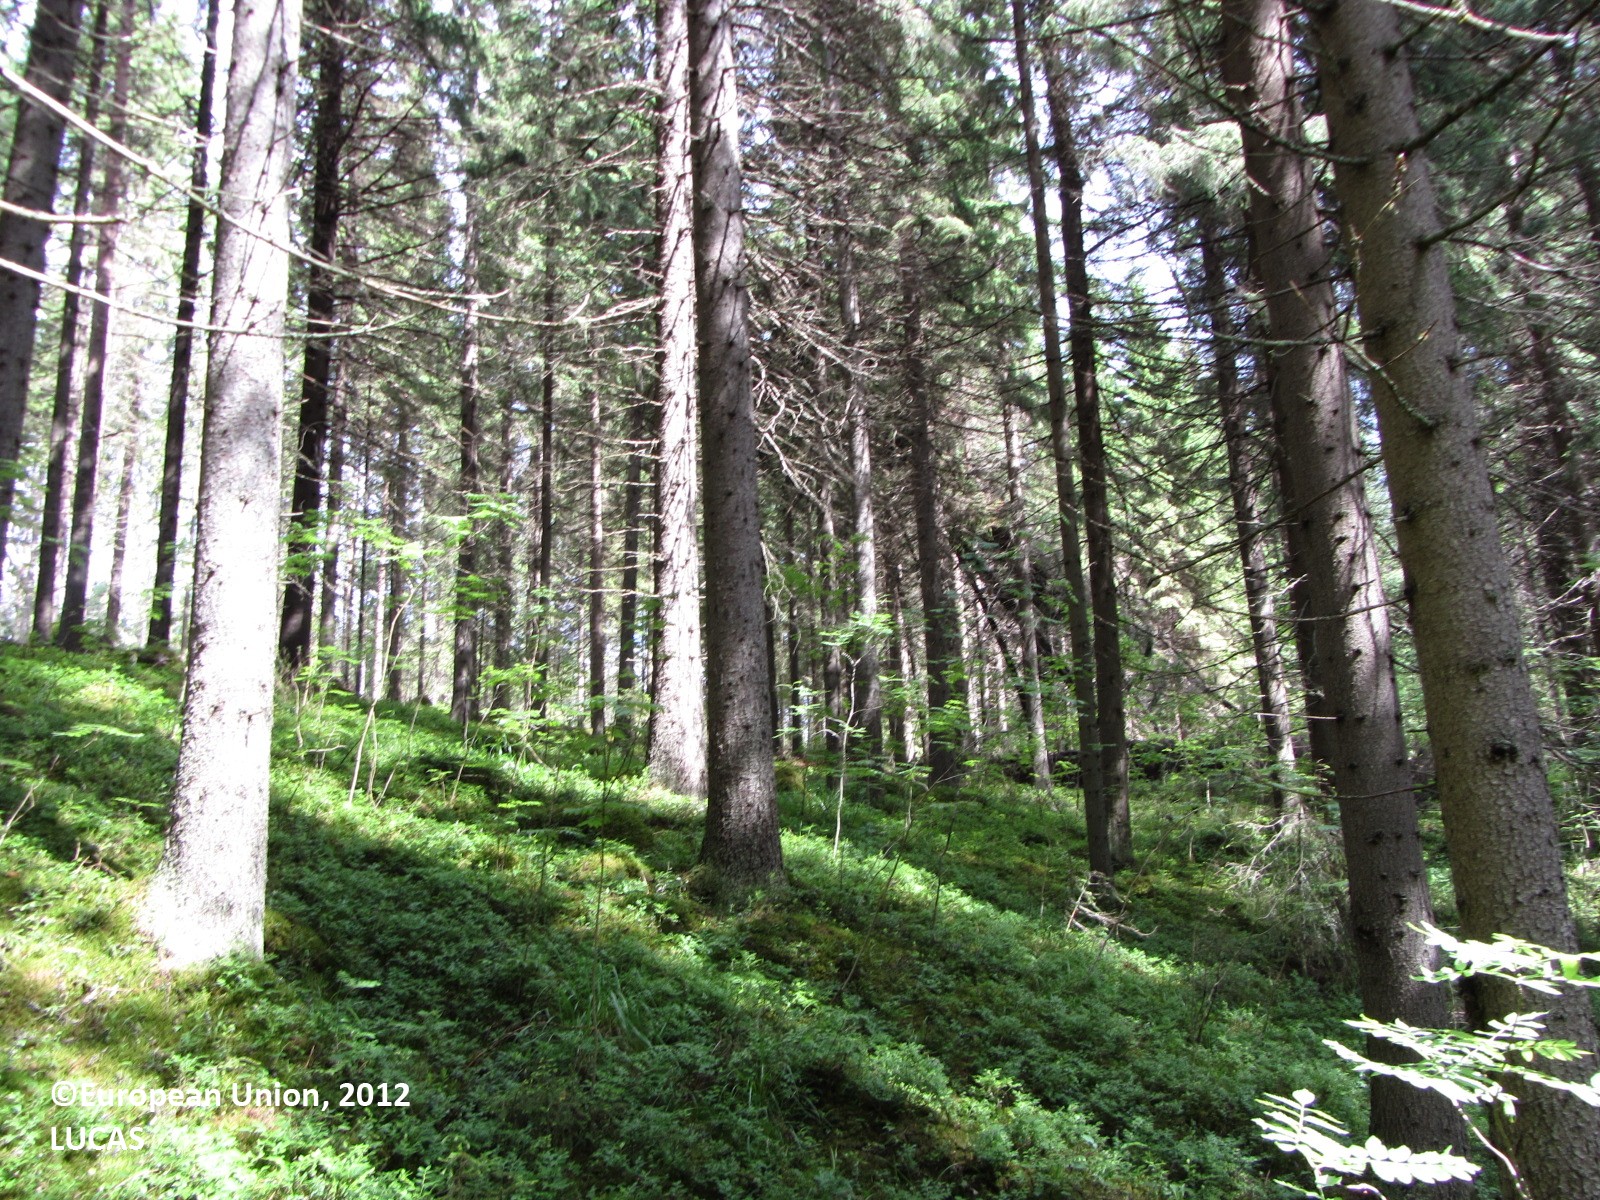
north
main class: Woodland
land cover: Spruce dominated coniferous woodland
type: boreal forest
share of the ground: > 75 %
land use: Forestry
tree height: > 5 m
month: June
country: FI
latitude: 61.9907
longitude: 25.2865
